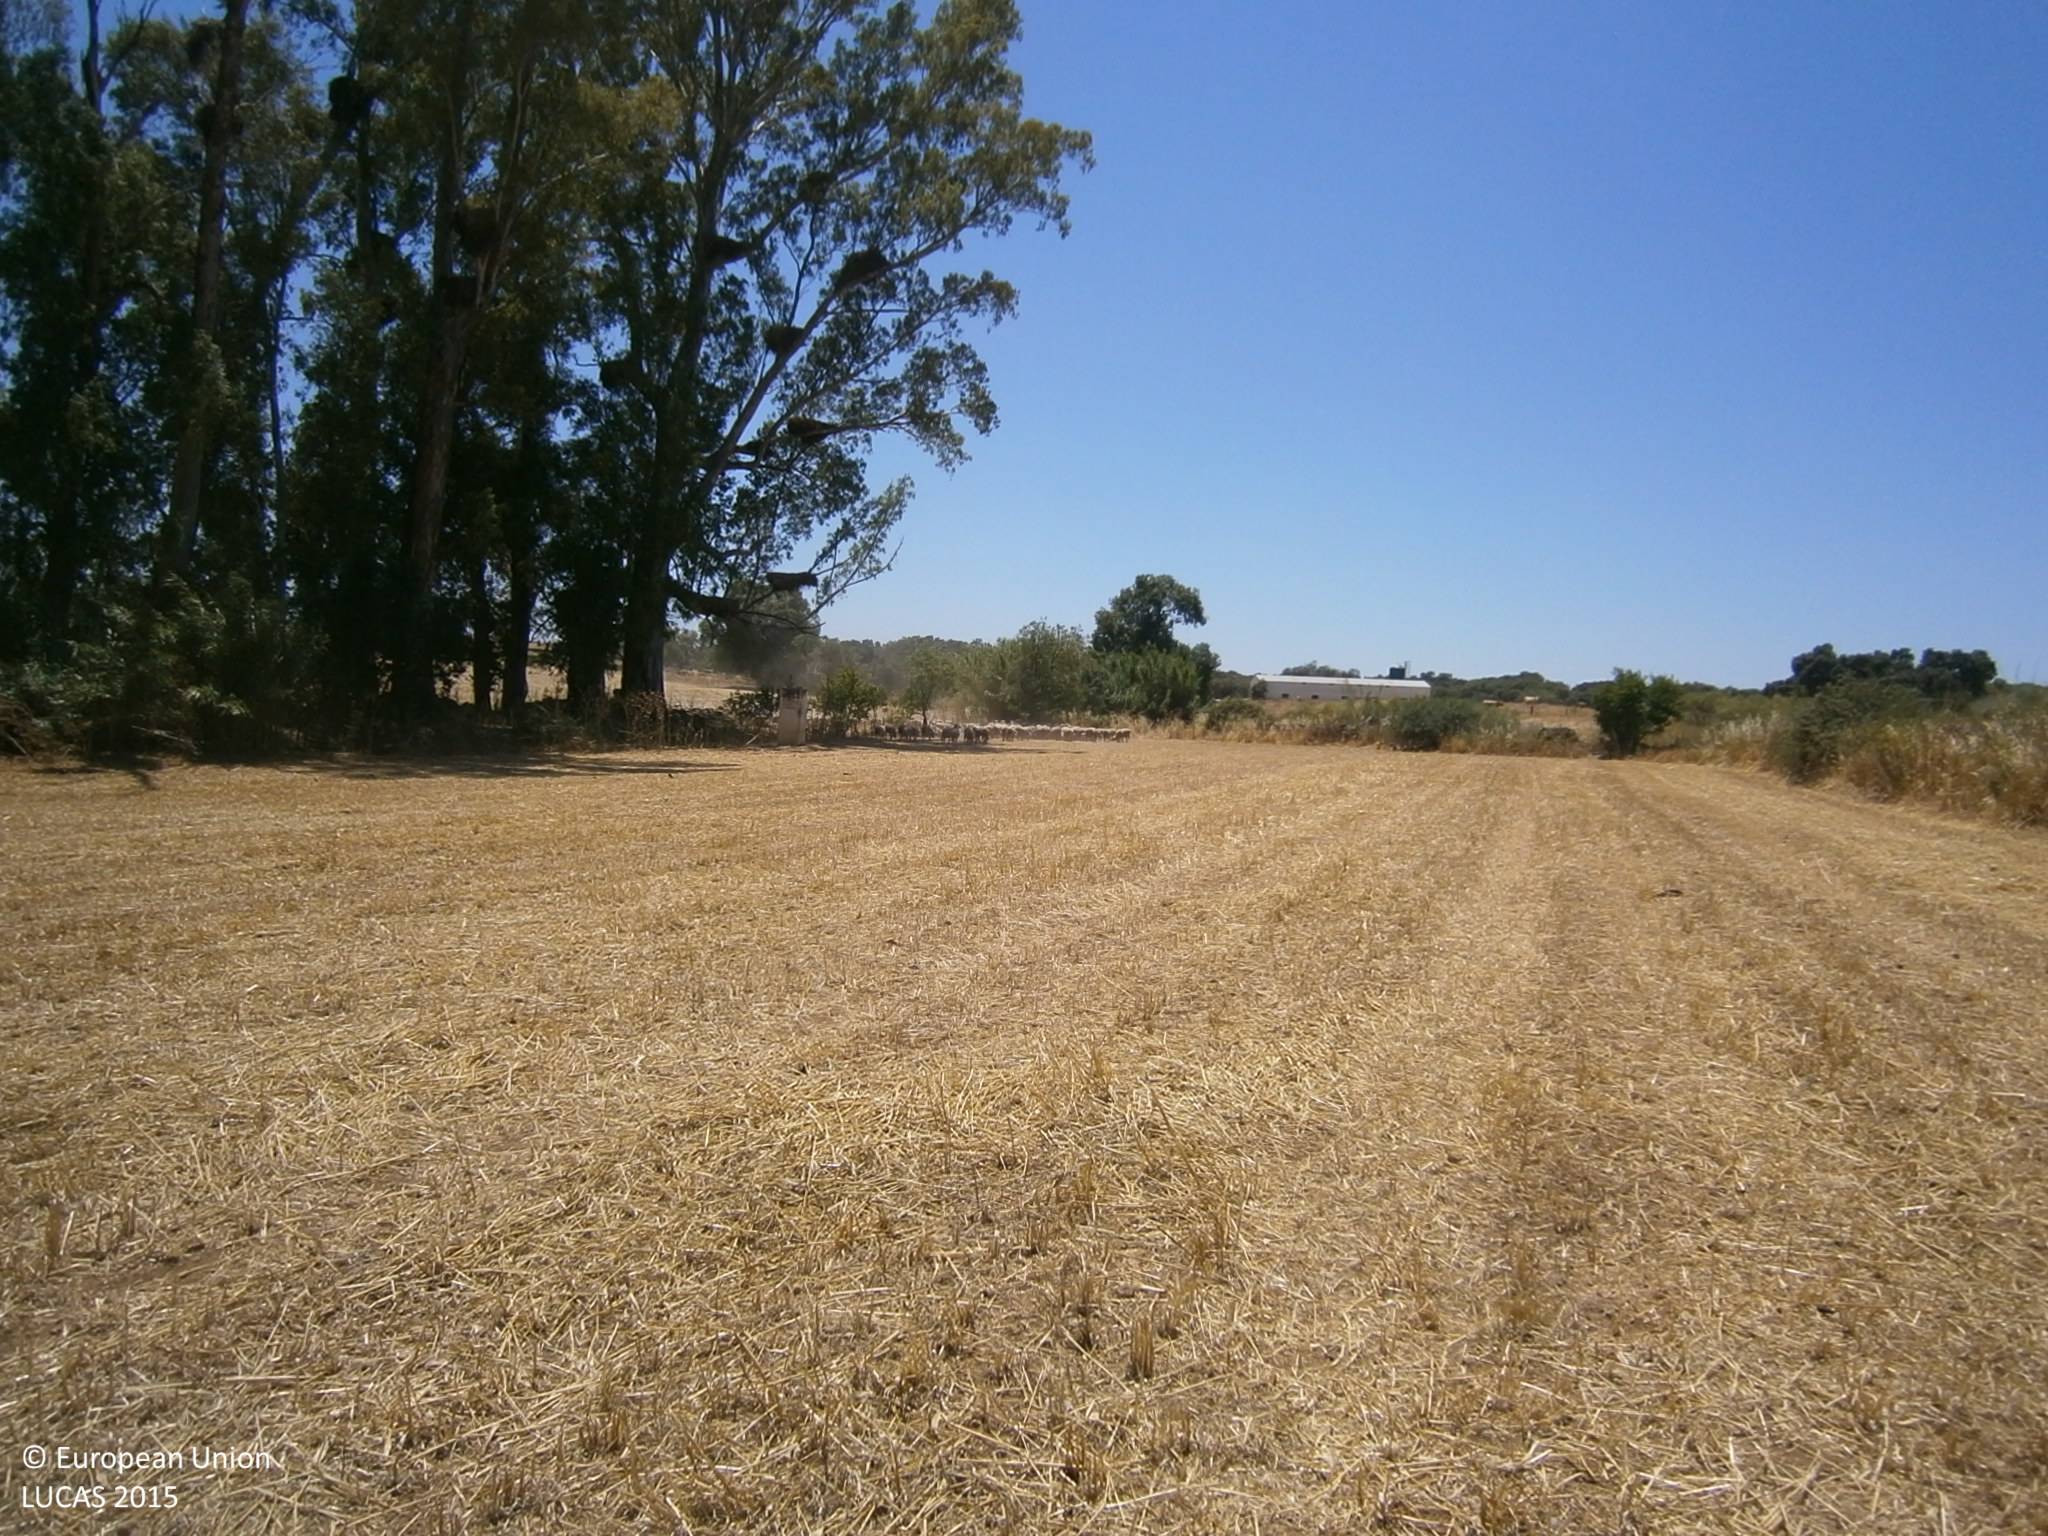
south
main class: Cropland
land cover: Mixed cereals for fodder
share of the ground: > 75 %
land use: Agriculture (excluding fallow land and kitchen gardens)
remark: Harvested field
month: June
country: ES
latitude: 38.6641
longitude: -6.8775
